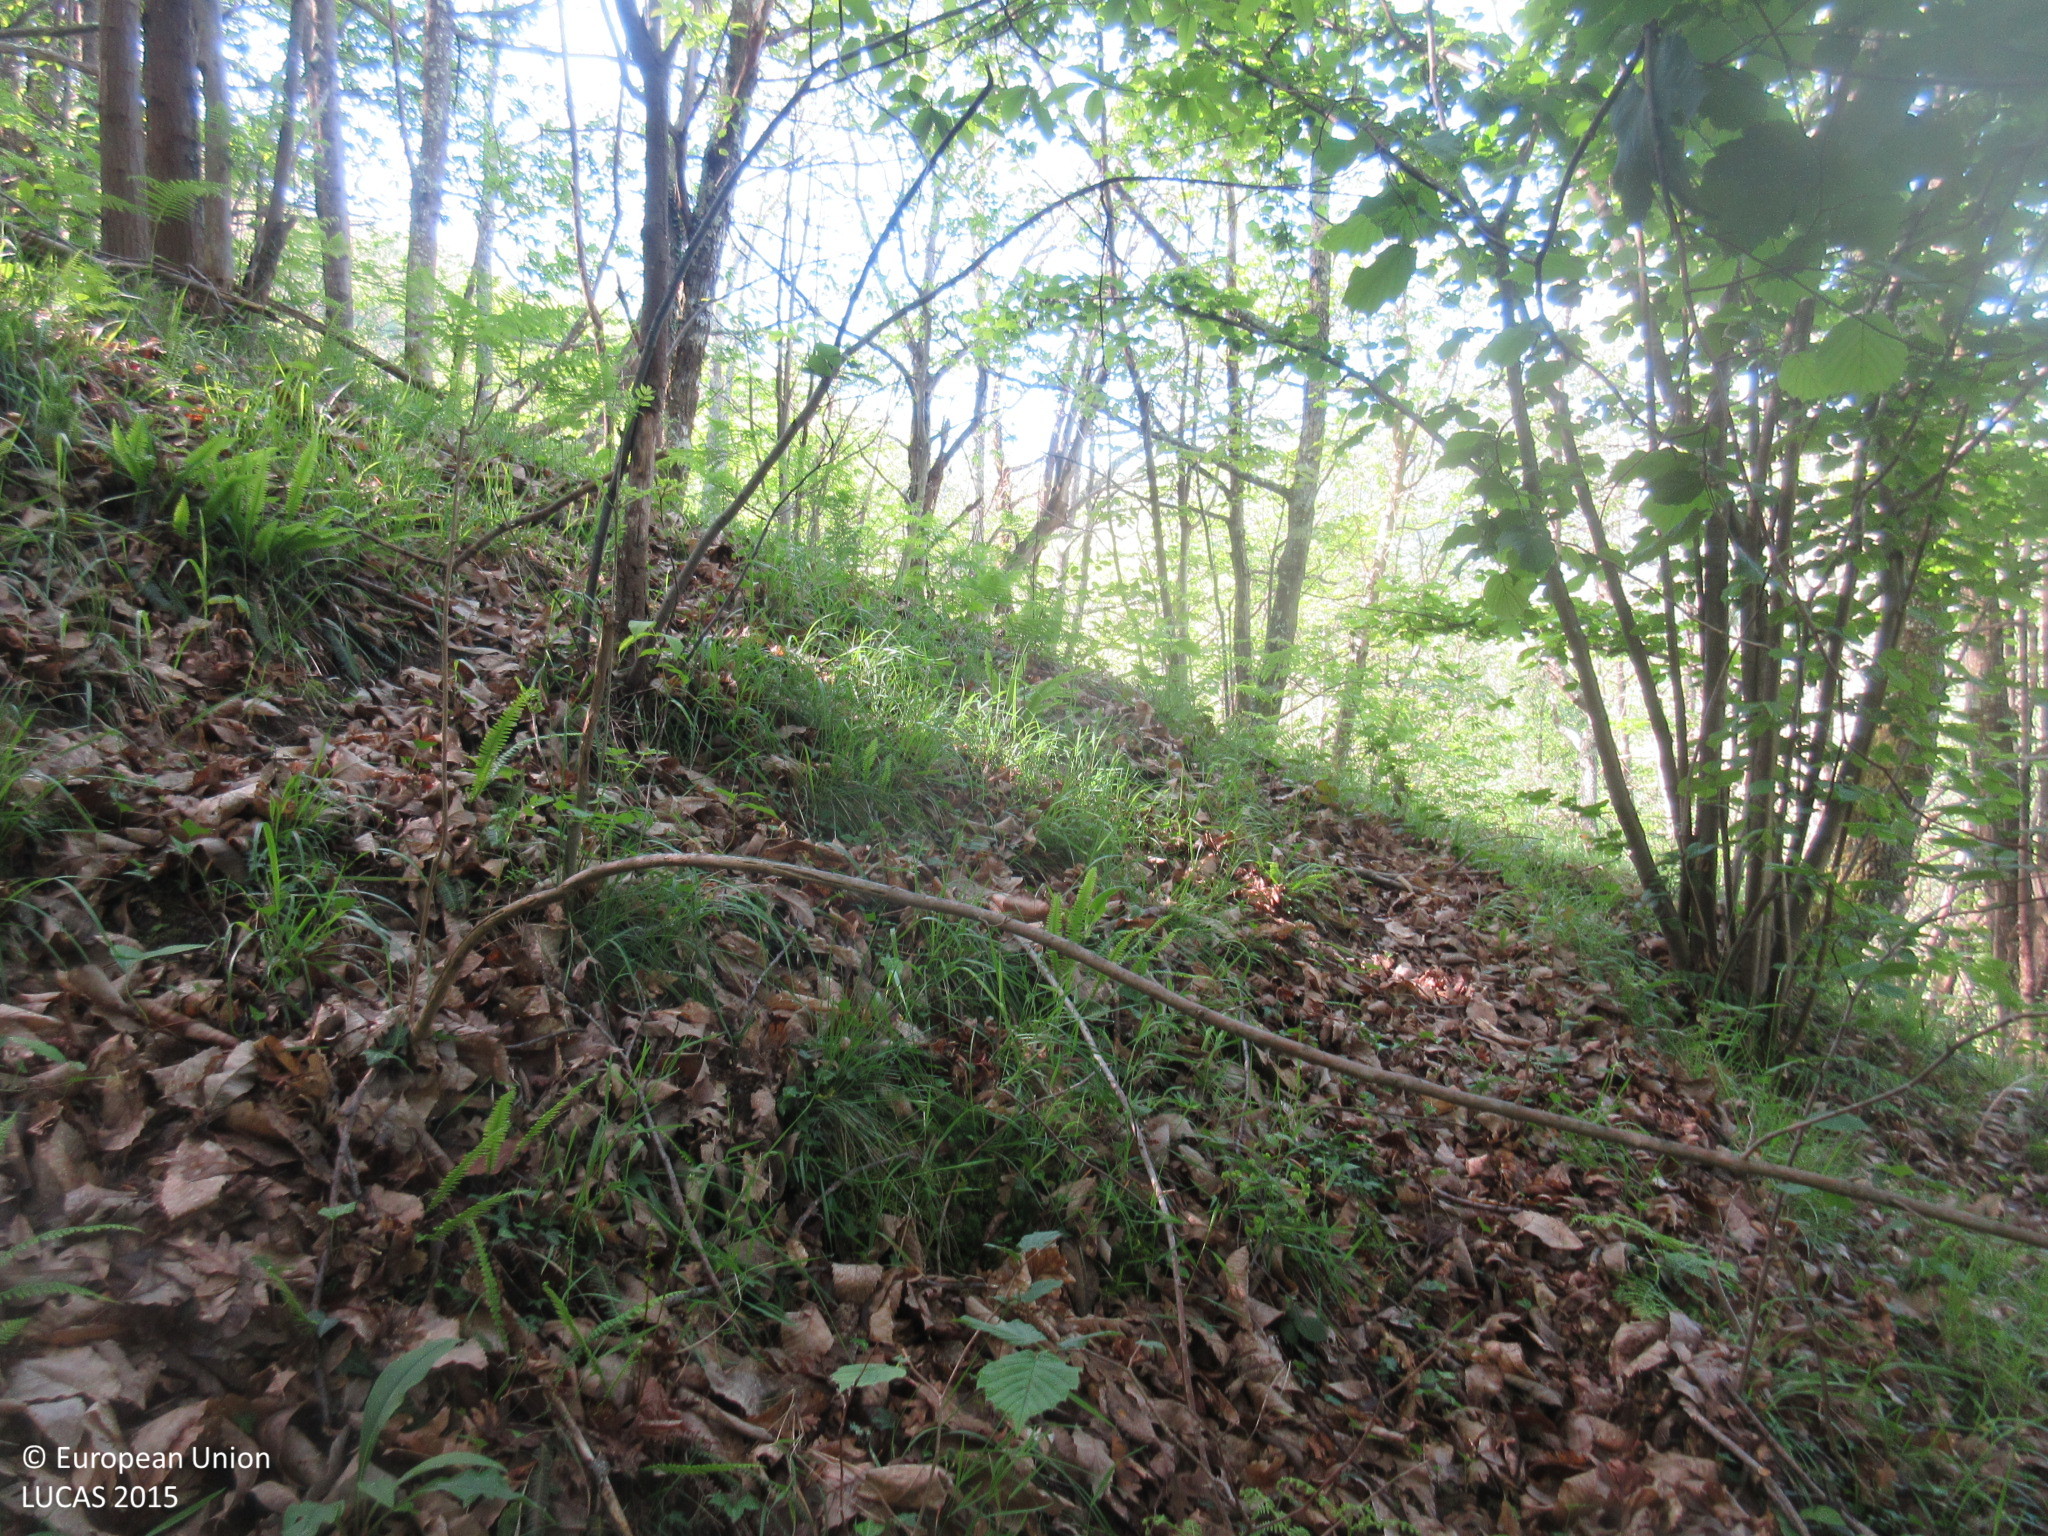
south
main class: Woodland
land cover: Broadleaved woodland
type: thermophilous deciduous forest
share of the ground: > 75 %
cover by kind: broadleaved forest trees 95 %, shrubs 5 %
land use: Forestry
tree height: > 5 m
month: May
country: ES
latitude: 43.2276
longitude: -5.5311
